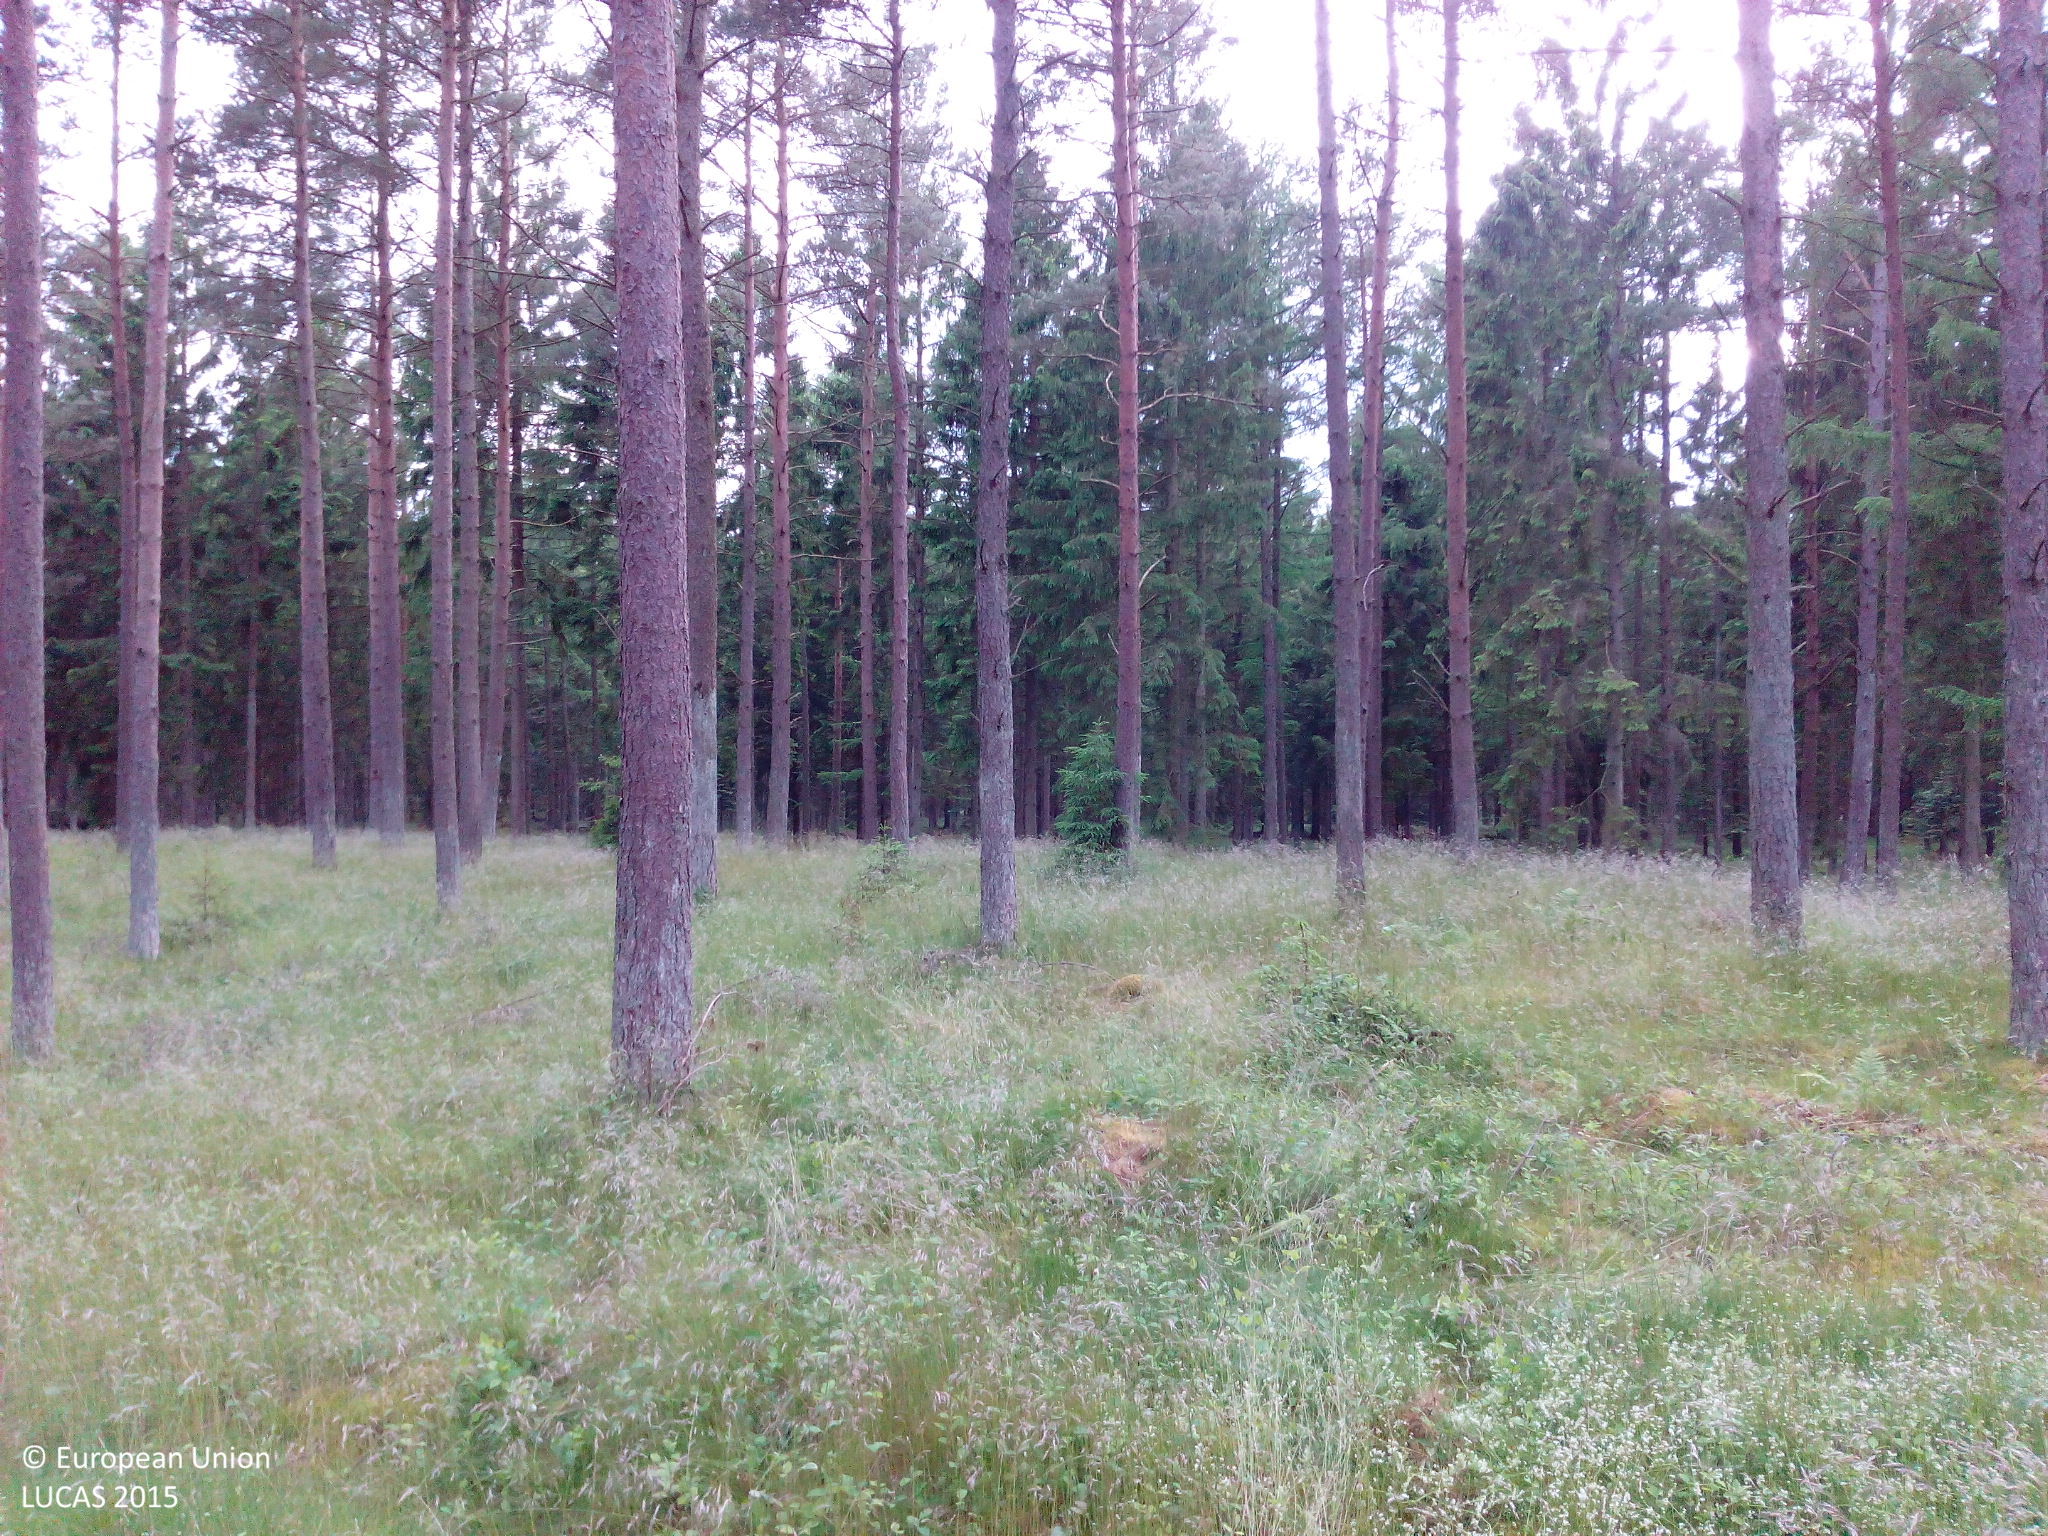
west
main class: Woodland
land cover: Pine dominated coniferous woodland
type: hemiboreal forest and nemoral coniferous forest and mixed broadleaved-coniferous forest
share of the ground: 25 - 50 %
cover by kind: herbaceous plants 50 %, coniferous forest trees 30 %, lichens and mosses 20 %
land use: Forestry
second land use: Amenities, museums, leisure
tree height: > 5 m
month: June
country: DK
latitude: 56.2939
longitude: 10.6616
